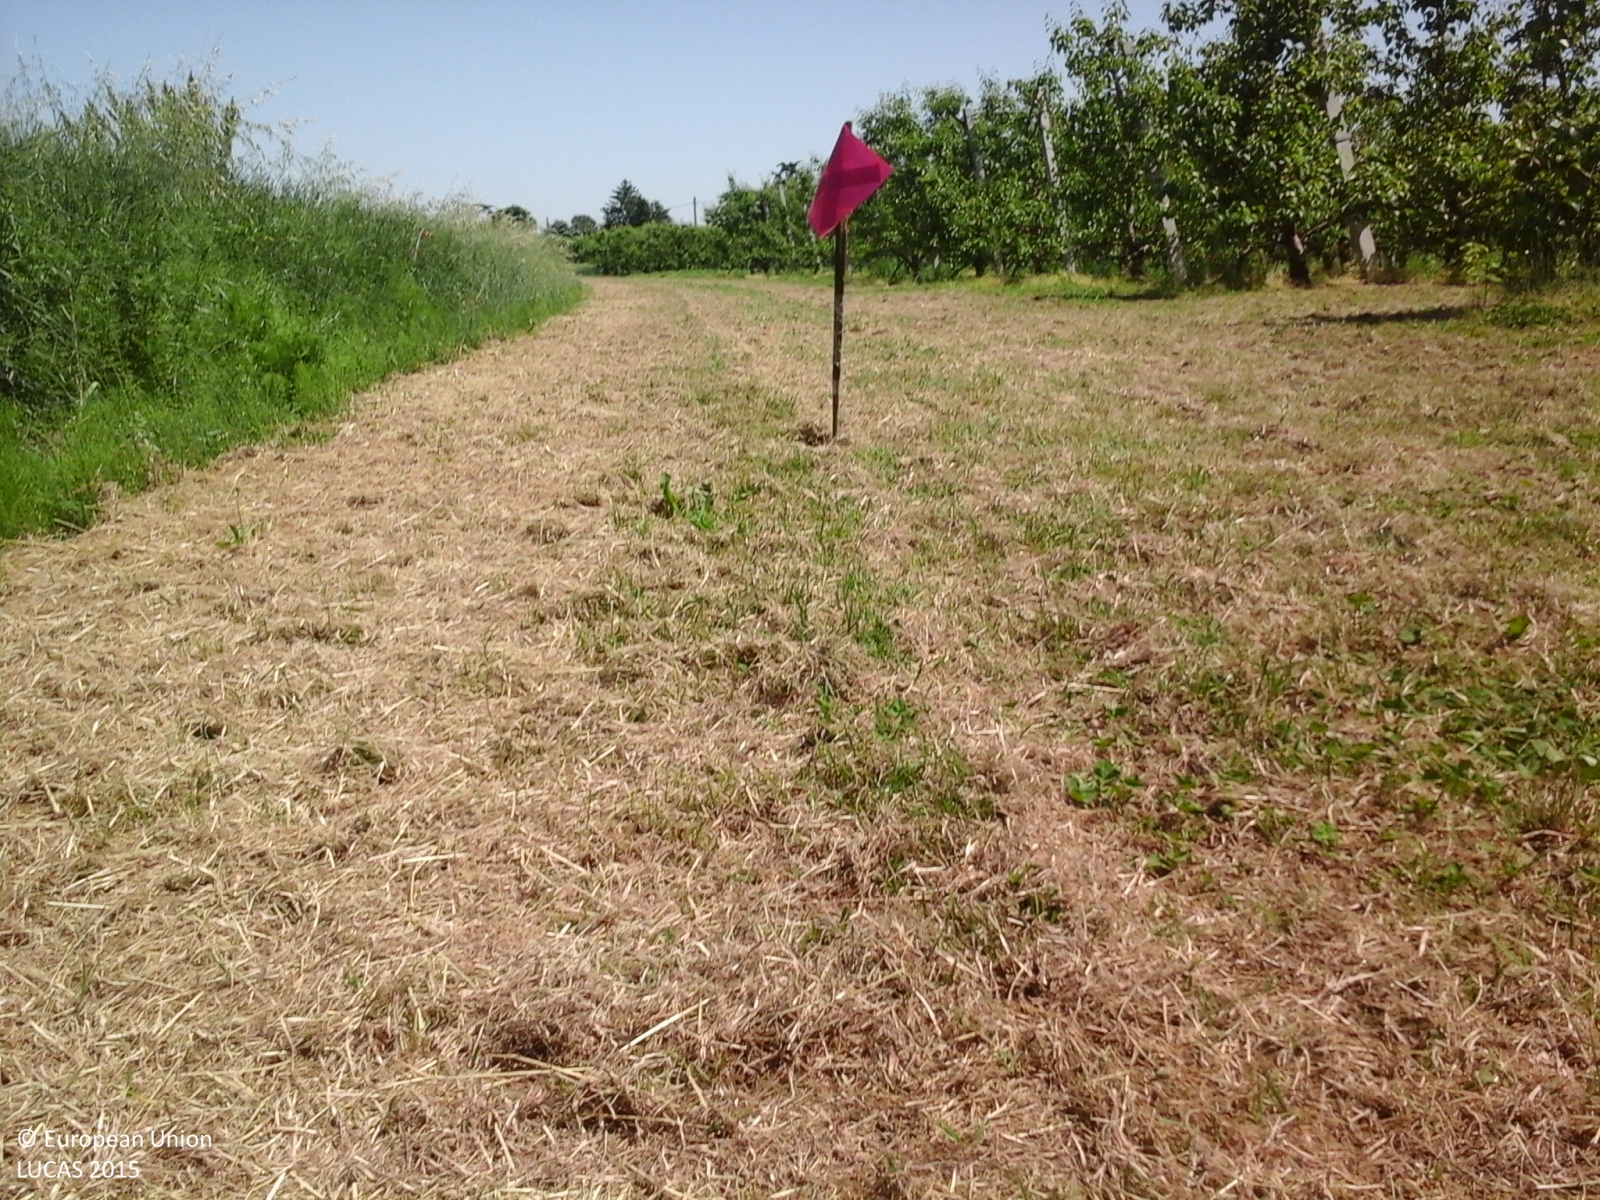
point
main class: Grassland
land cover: Grassland without tree/shrub cover
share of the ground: > 75 %
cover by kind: herbaceous plants 100 %
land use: Agriculture (excluding fallow land and kitchen gardens)
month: May
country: IT
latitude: 44.8122
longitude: 11.2241
